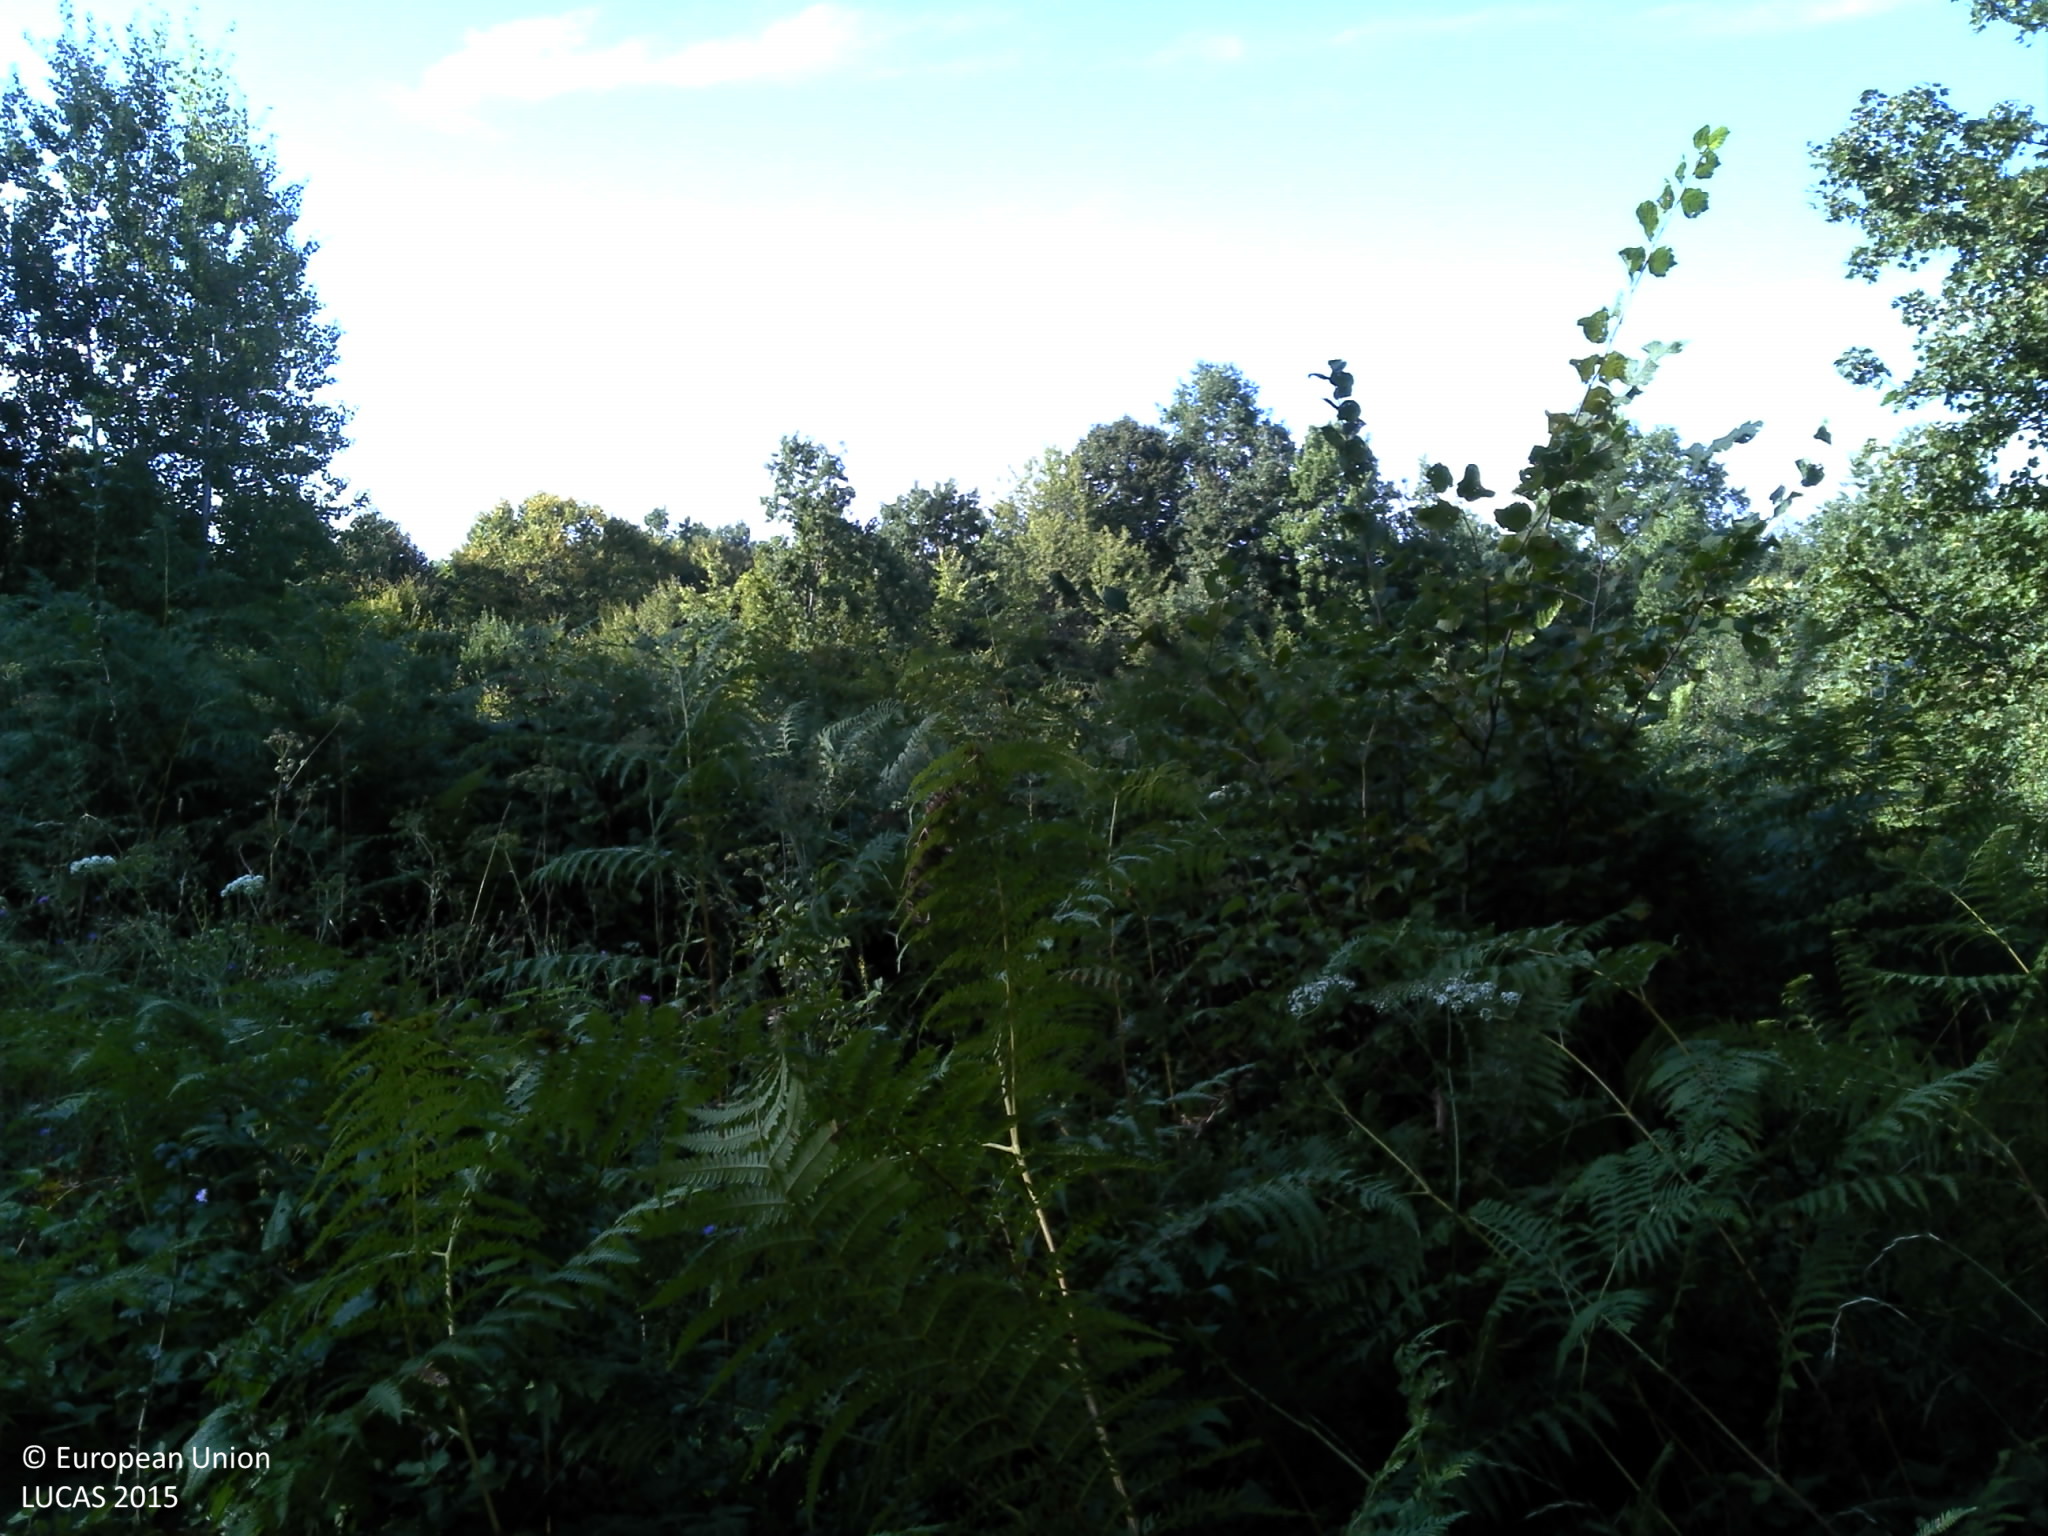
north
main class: Shrubland
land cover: Shrubland without tree cover
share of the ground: > 75 %
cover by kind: shrubs 100 %
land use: Semi-natural and natural areas not in use
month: September
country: HR
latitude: 45.0629
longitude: 15.6720
